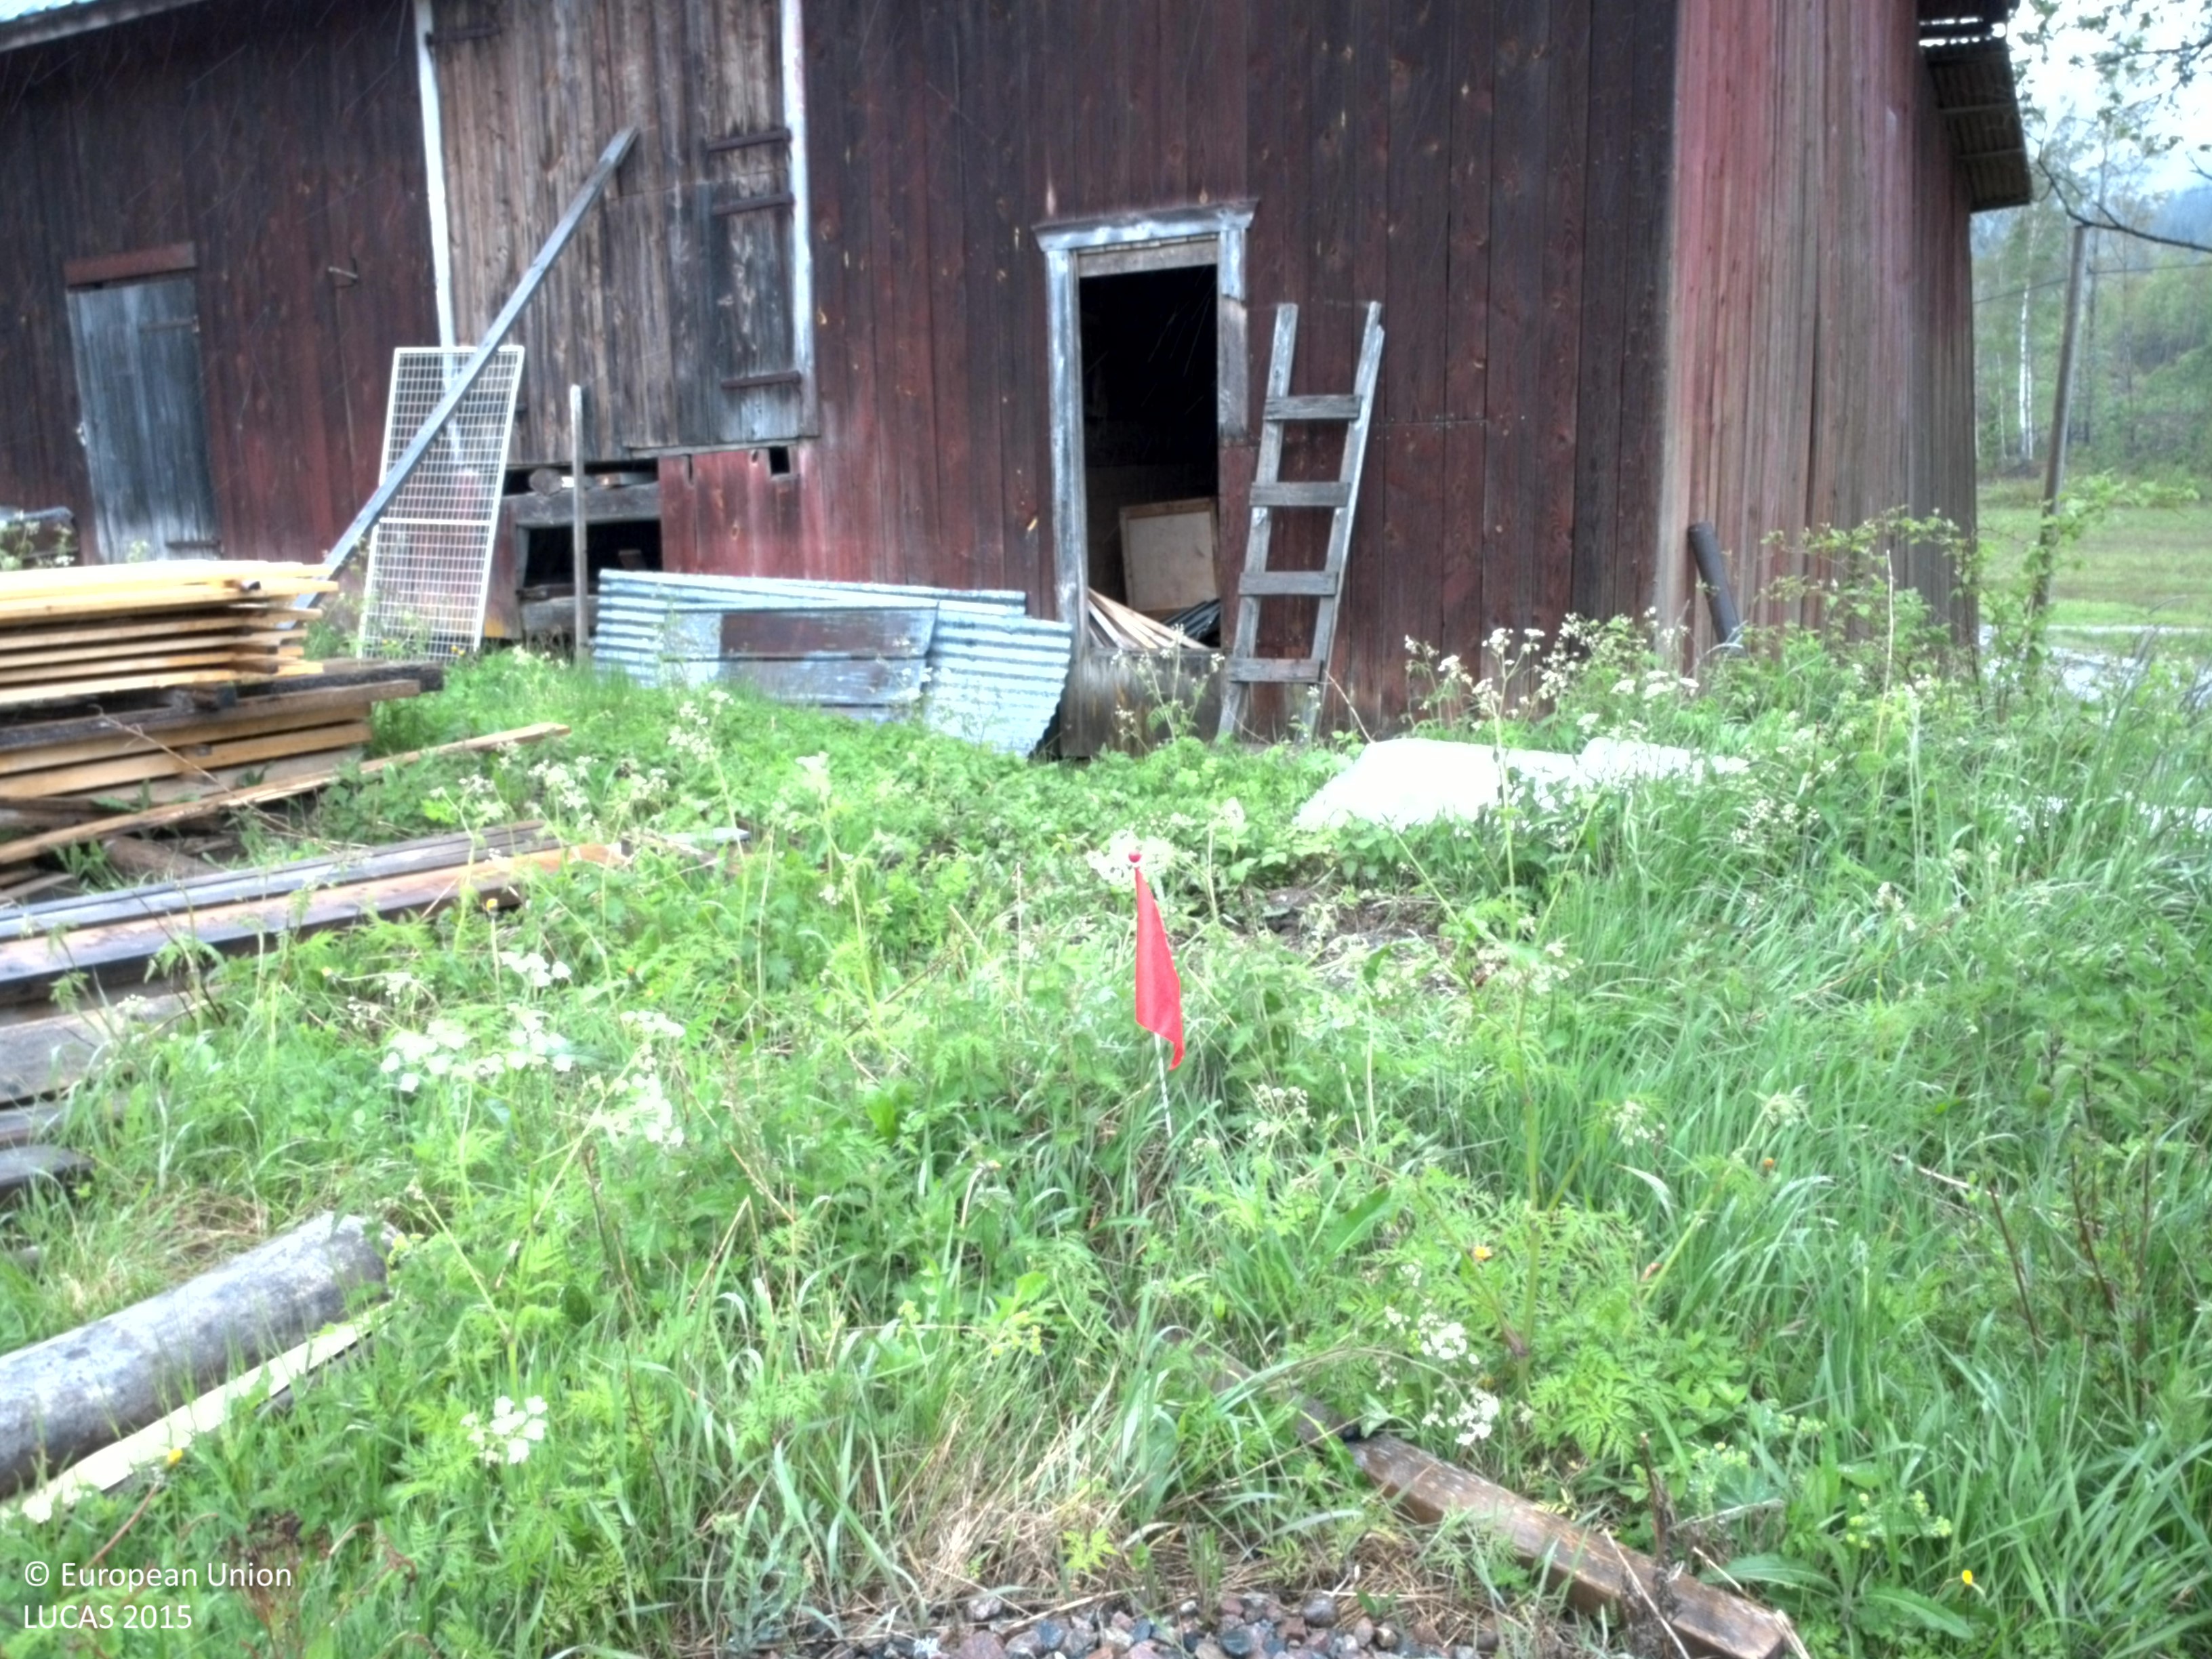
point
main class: Grassland
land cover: Spontaneously vegetated surfaces
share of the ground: > 75 %
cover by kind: herbaceous plants 90 %, shrubs 5 %
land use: Residential
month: June
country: SE
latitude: 59.6915
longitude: 12.4273
